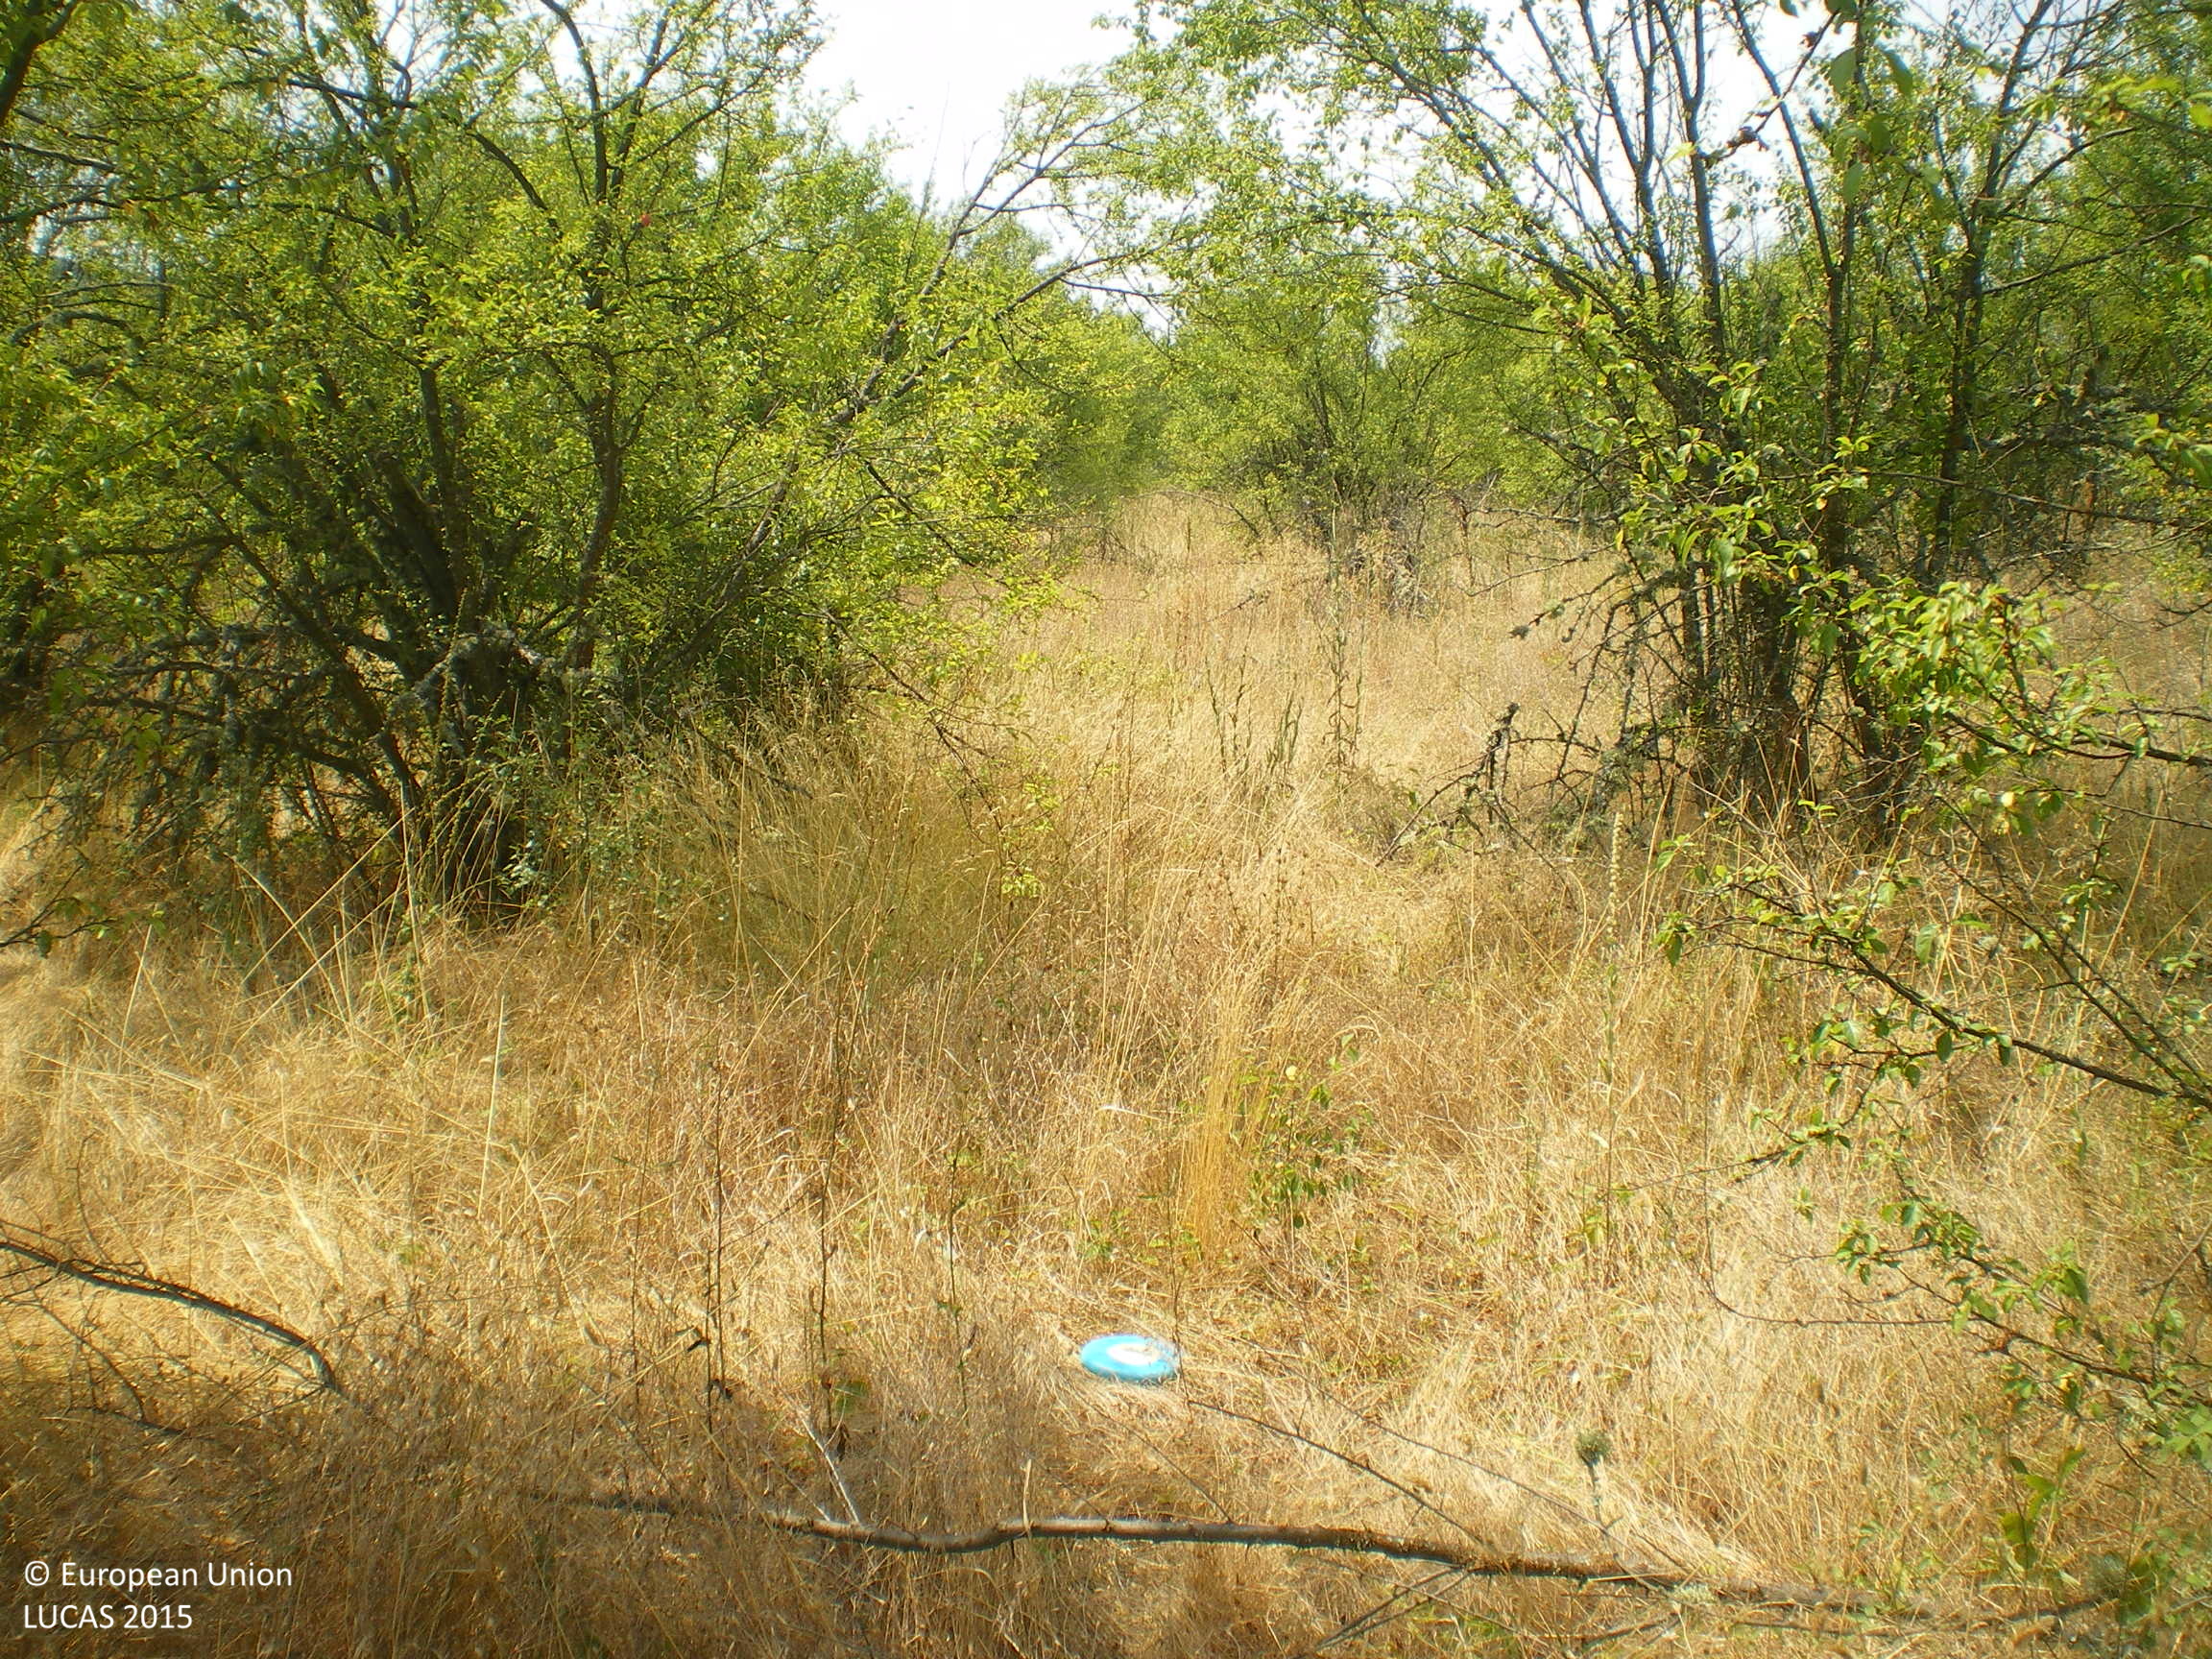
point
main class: Cropland
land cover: Other fruit trees and berries
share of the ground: 50 - 75 %
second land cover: Grassland without tree/shrub cover
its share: 25 - 50 %
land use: Abandoned areas
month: August
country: BG
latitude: 42.3845
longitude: 25.4075
